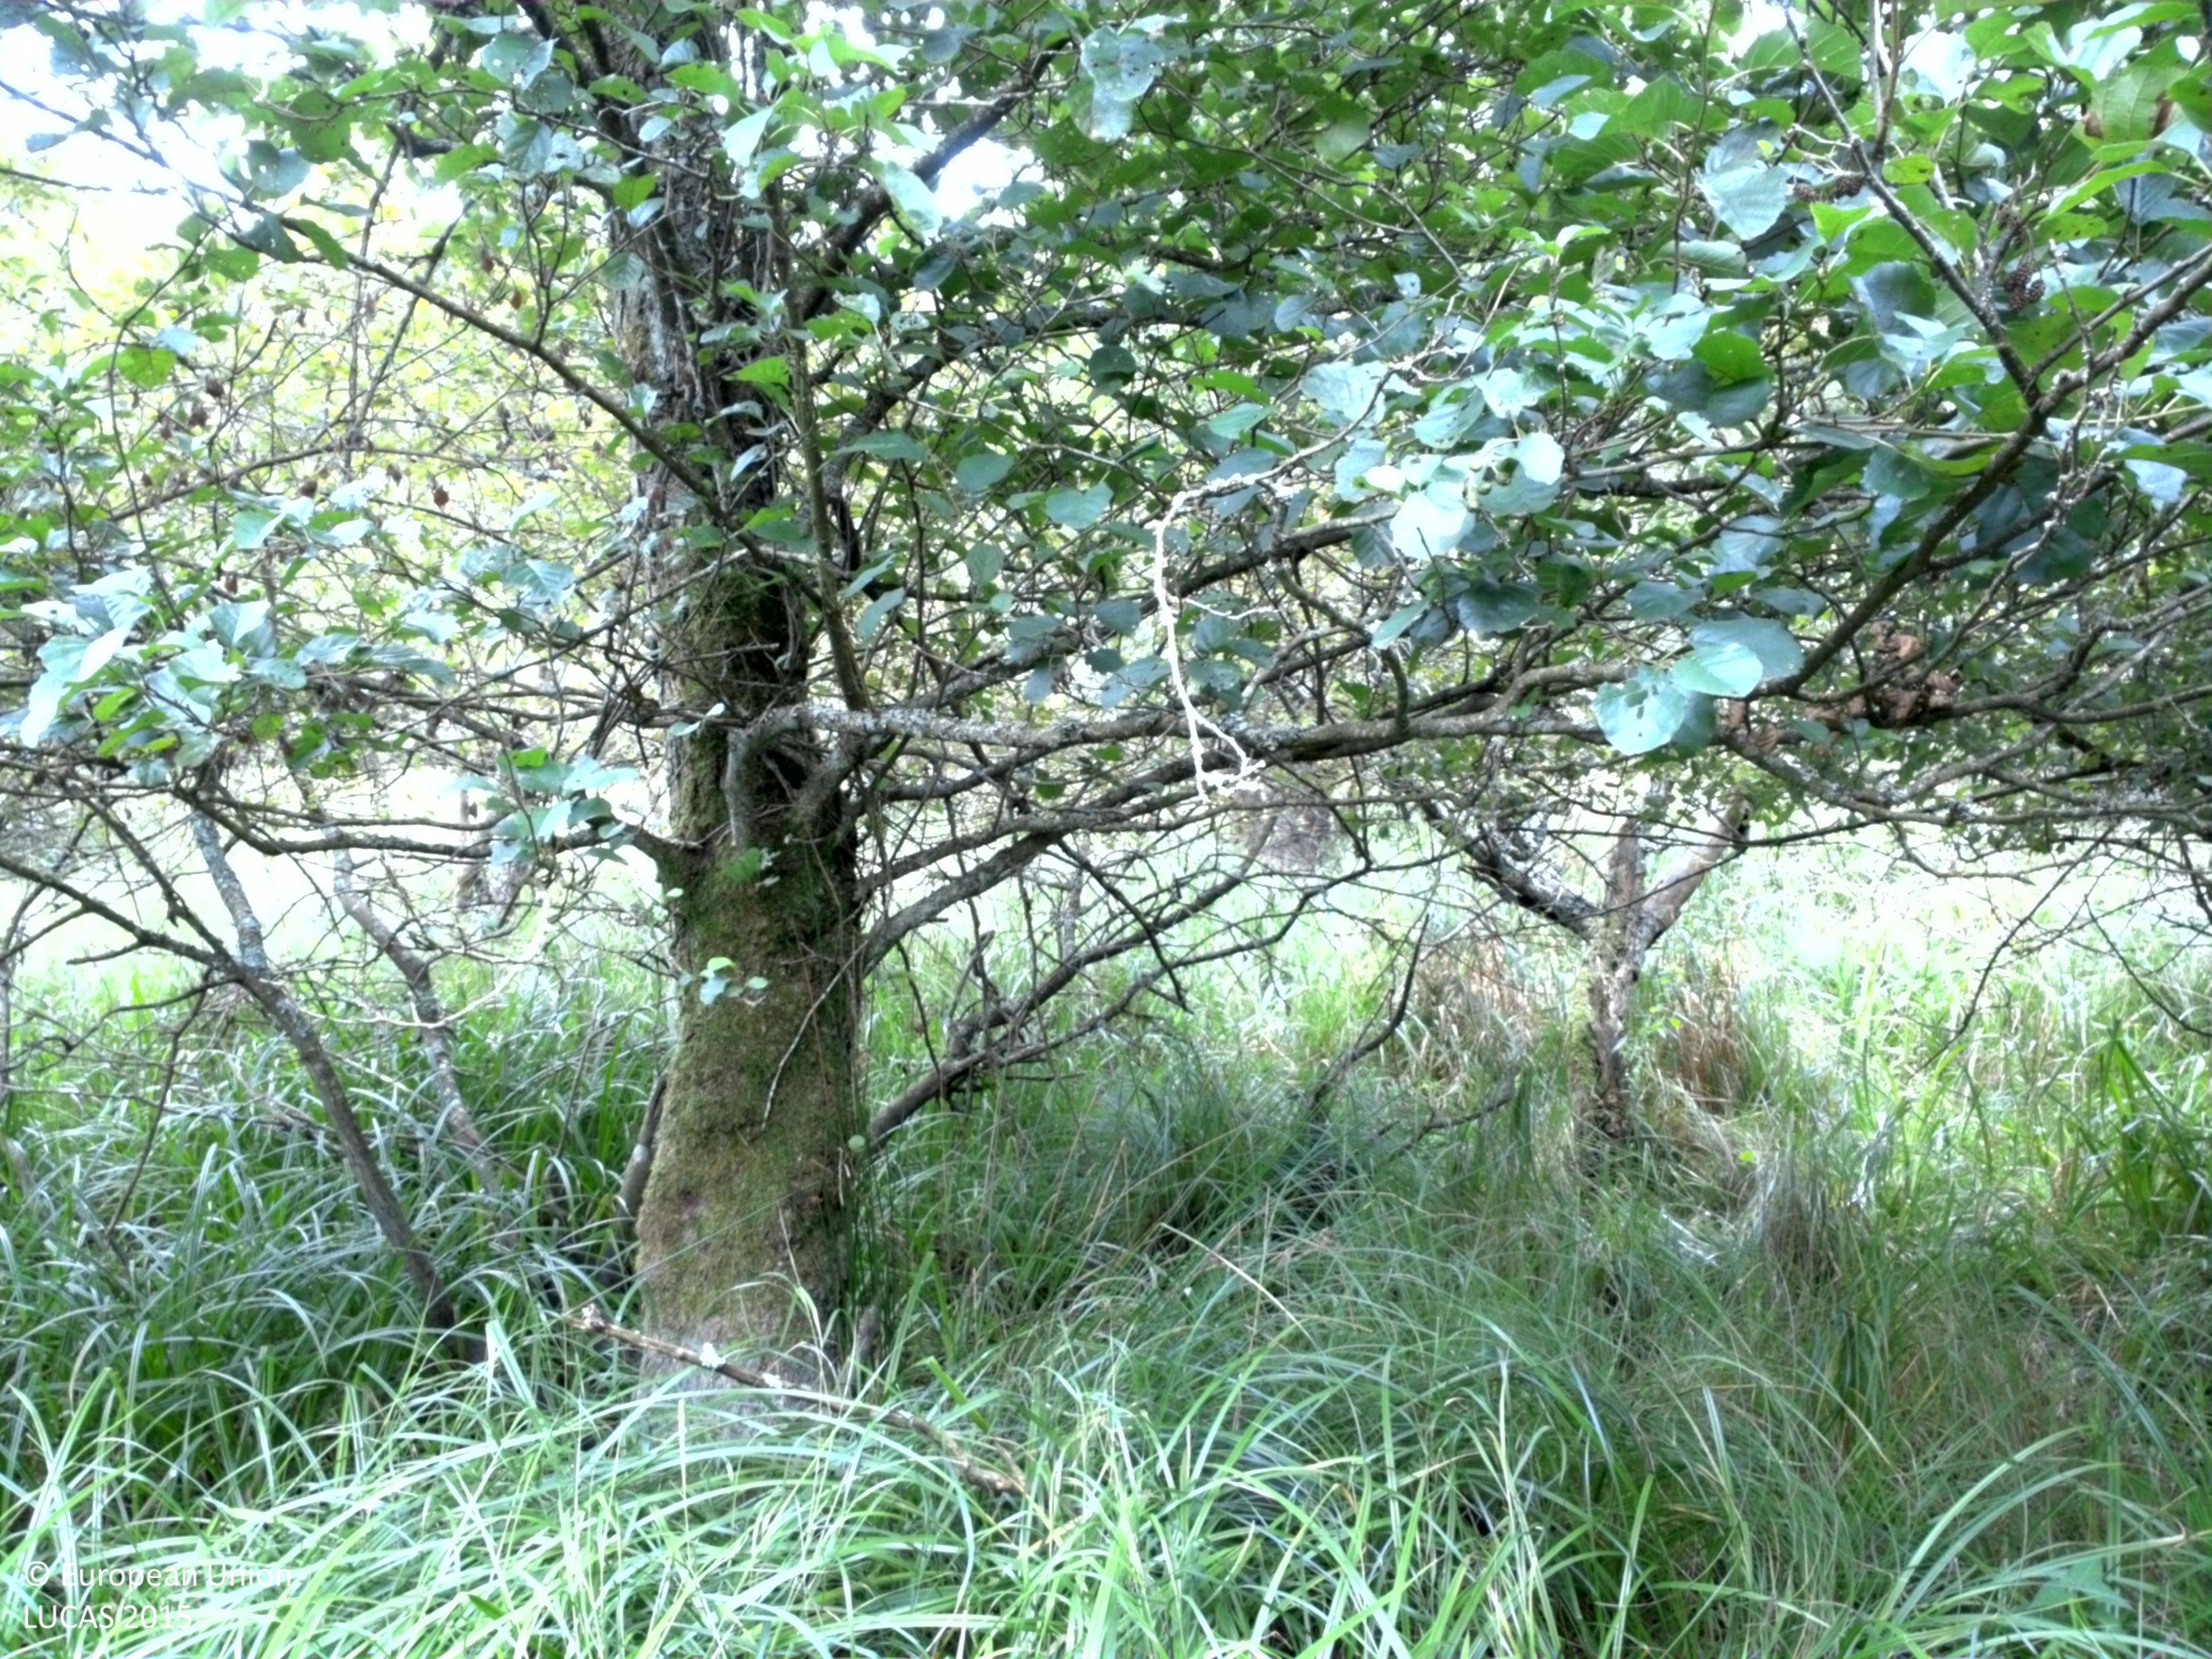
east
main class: Woodland
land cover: Broadleaved woodland
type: mesophytic deciduous forest
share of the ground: 25 - 50 %
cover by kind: herbaceous plants 50 %, broadleaved forest trees 40 %, shrubs 10 %
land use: Forestry
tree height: < 5 m
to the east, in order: Broadleaved woodland; Other coniferous woodland; Broadleaved woodland; Fences; Broadleaved woodland; Grassland with sparse tree/shrub cover; Other mixed woodland
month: September
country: SE
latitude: 55.5409
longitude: 13.6906
